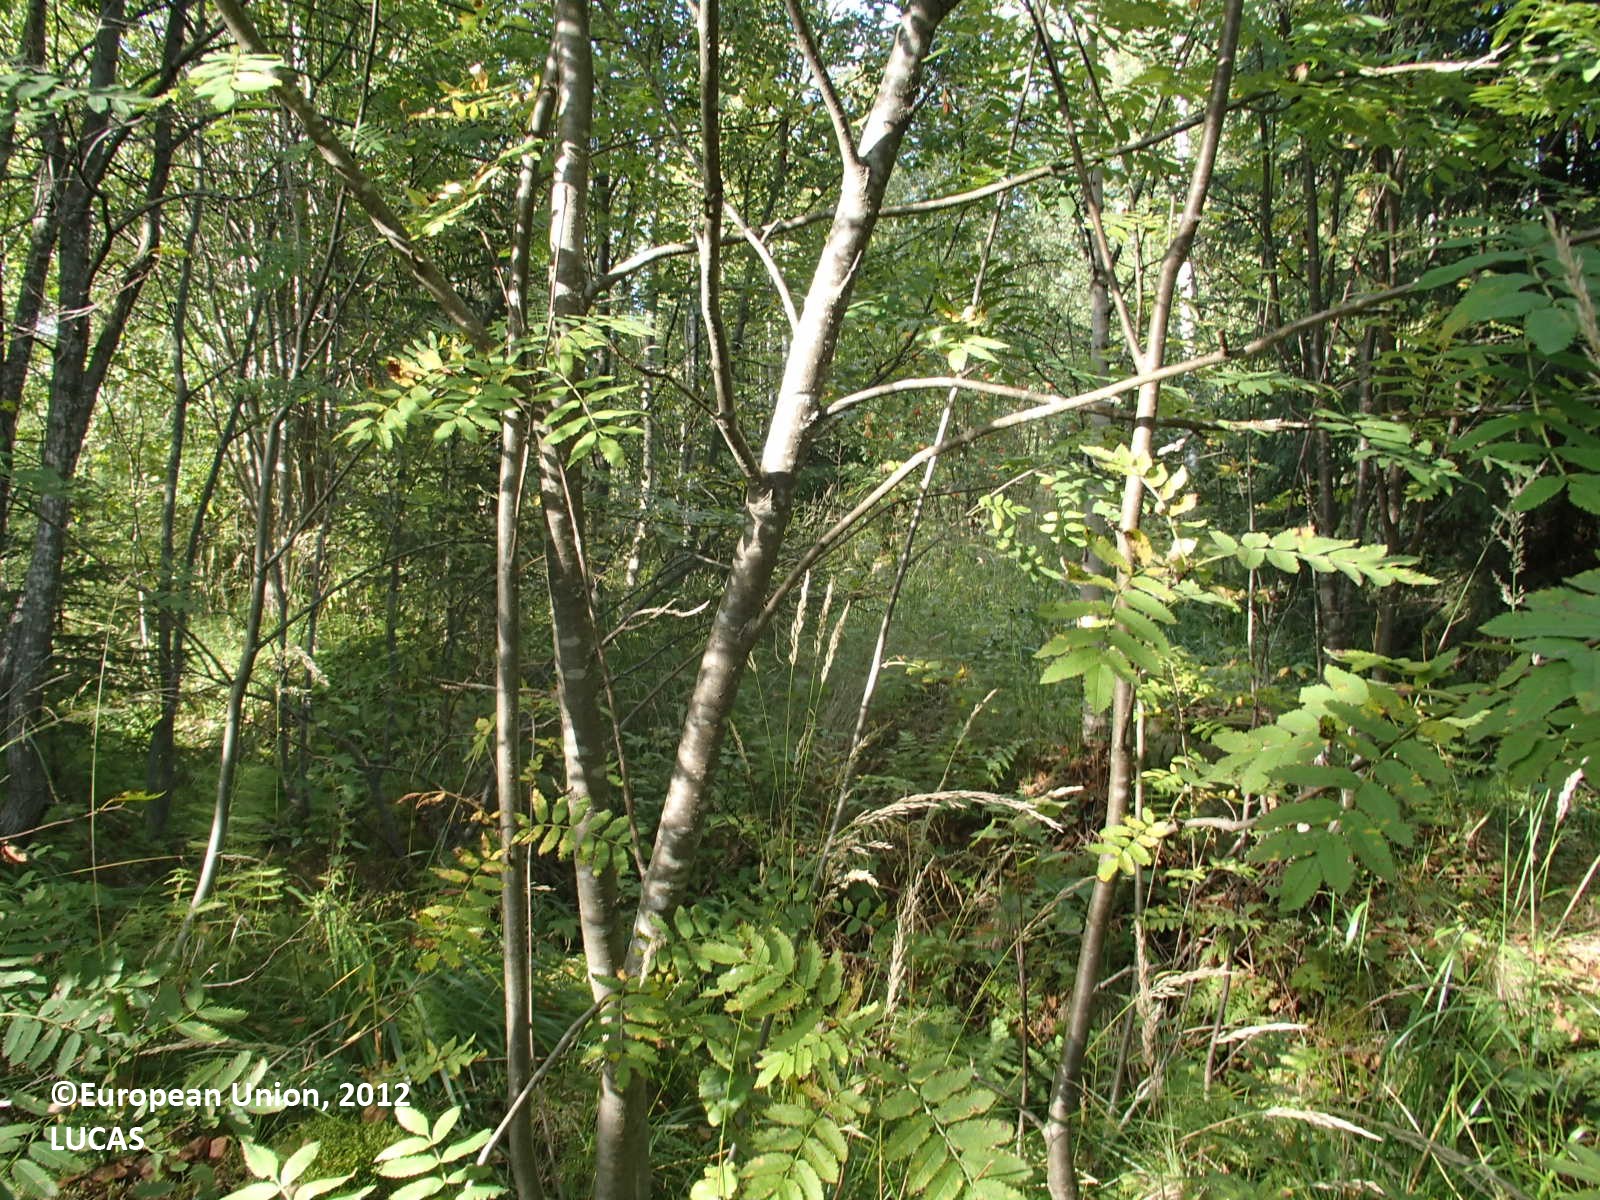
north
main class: Woodland
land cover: Spruce dominated mixed woodland
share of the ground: > 75 %
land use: Forestry
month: August
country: FI
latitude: 63.4571
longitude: 27.9210
